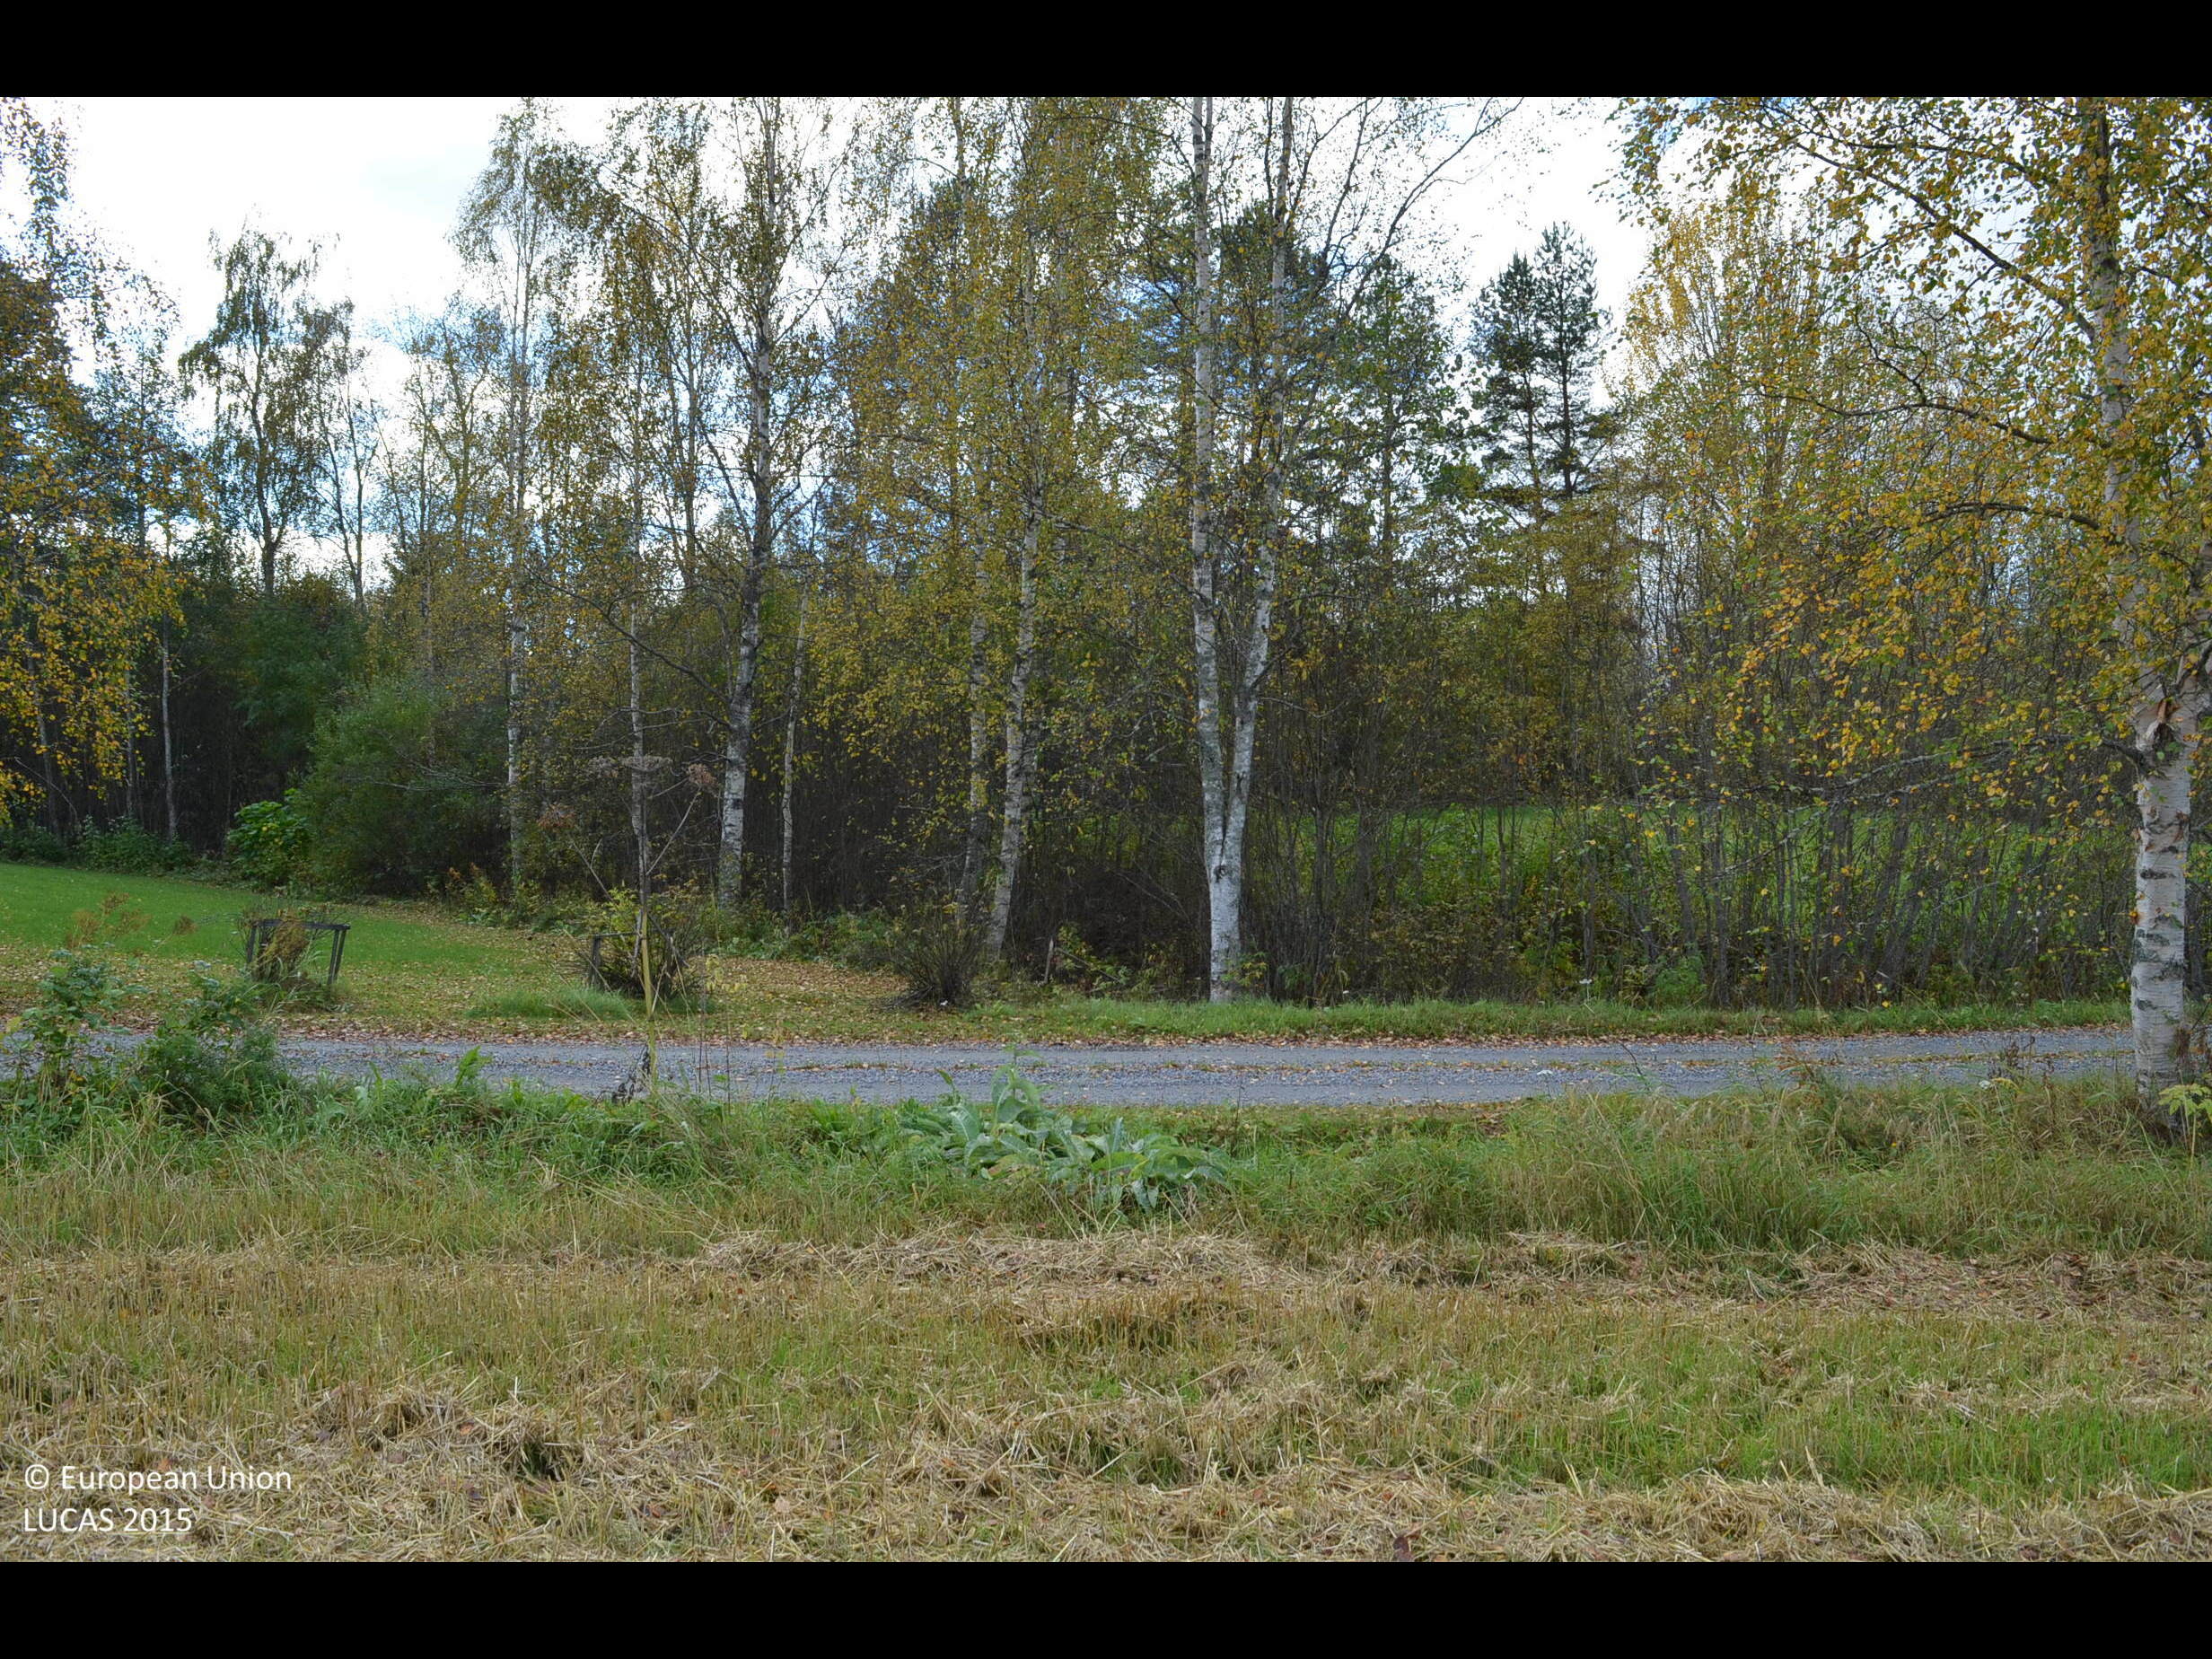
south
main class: Cropland
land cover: Barley
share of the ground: > 75 %
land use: Agriculture (excluding fallow land and kitchen gardens)
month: September
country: FI
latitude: 62.5753
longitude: 23.6375
